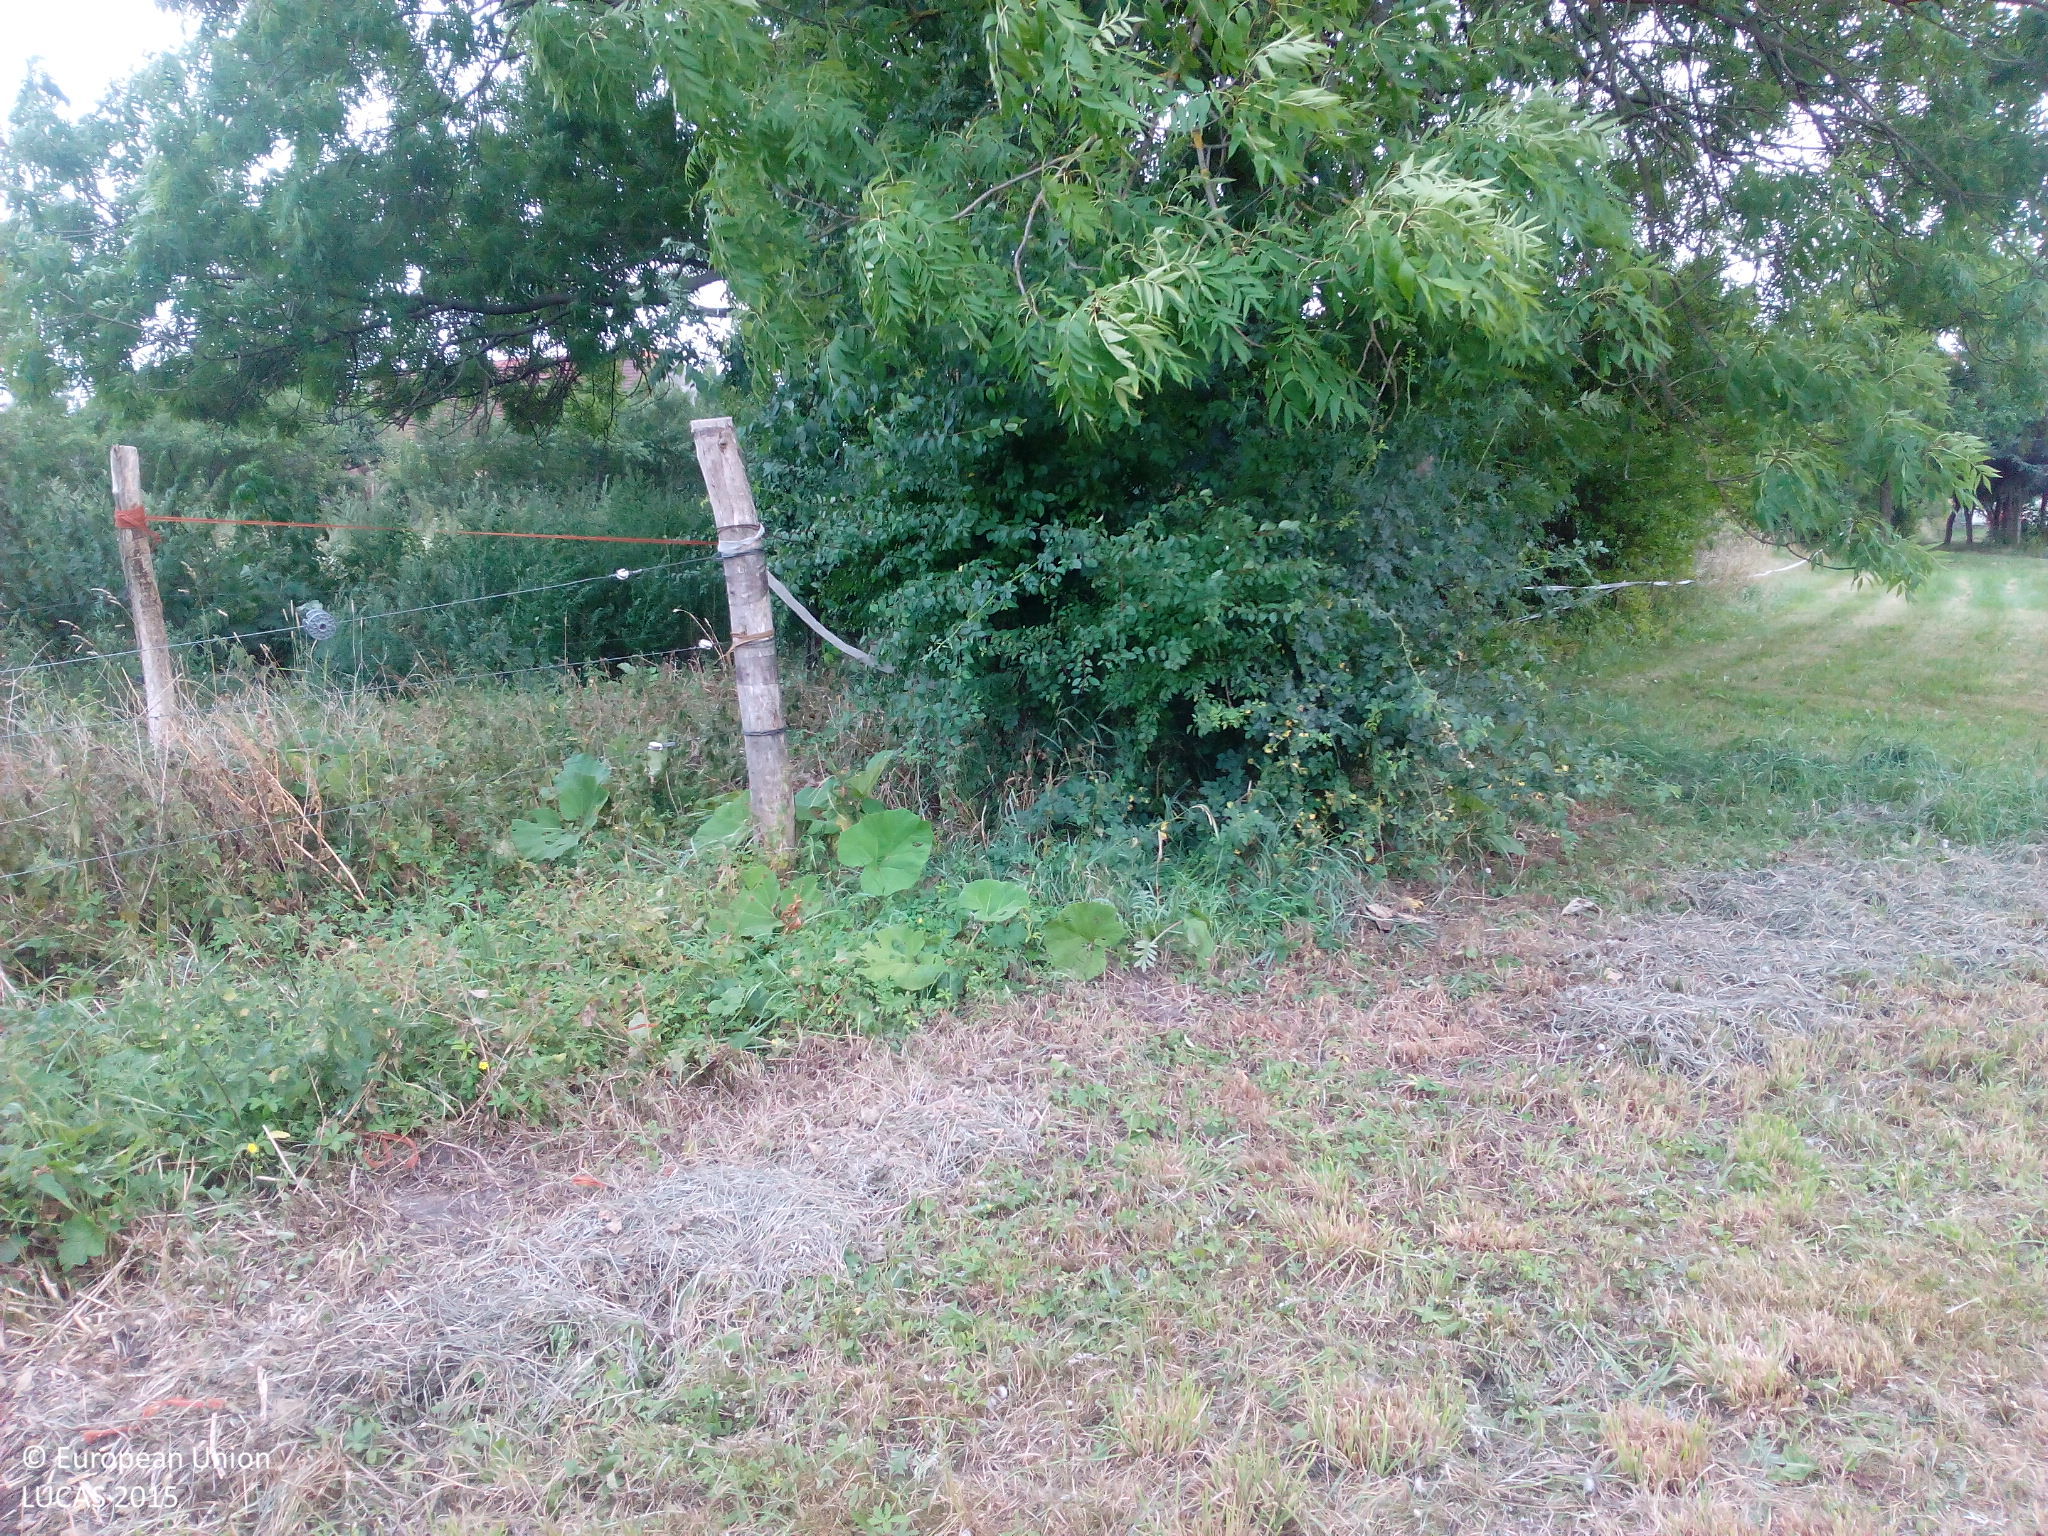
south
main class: Grassland
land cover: Grassland without tree/shrub cover
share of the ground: > 75 %
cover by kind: herbaceous plants 100 %
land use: Agriculture (excluding fallow land and kitchen gardens)
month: August
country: DE
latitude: 51.8141
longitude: 13.1478
